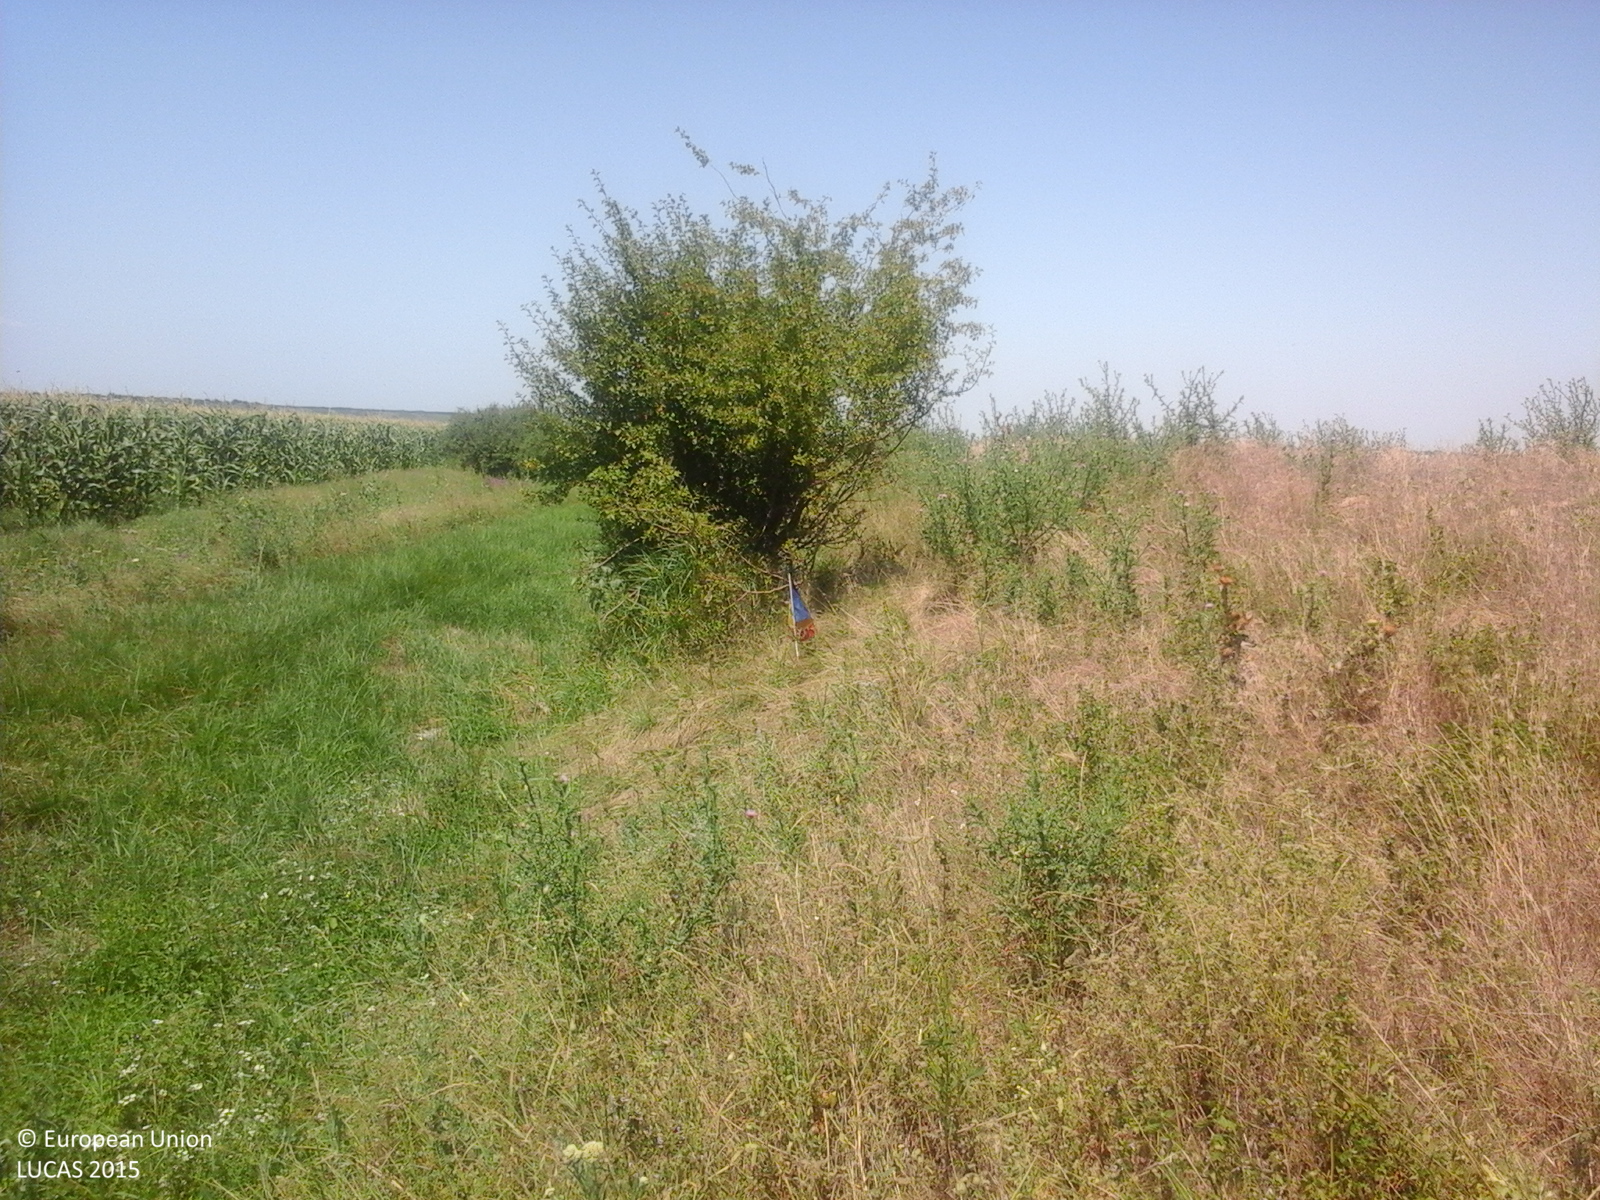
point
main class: Grassland
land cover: Grassland with sparse tree/shrub cover
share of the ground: > 75 %
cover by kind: herbaceous plants 85 %, shrubs 10 %, broadleaved forest trees 5 %
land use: Agriculture (excluding fallow land and kitchen gardens)
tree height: > 5 m
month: July
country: RO
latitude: 44.2608
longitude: 26.4327
